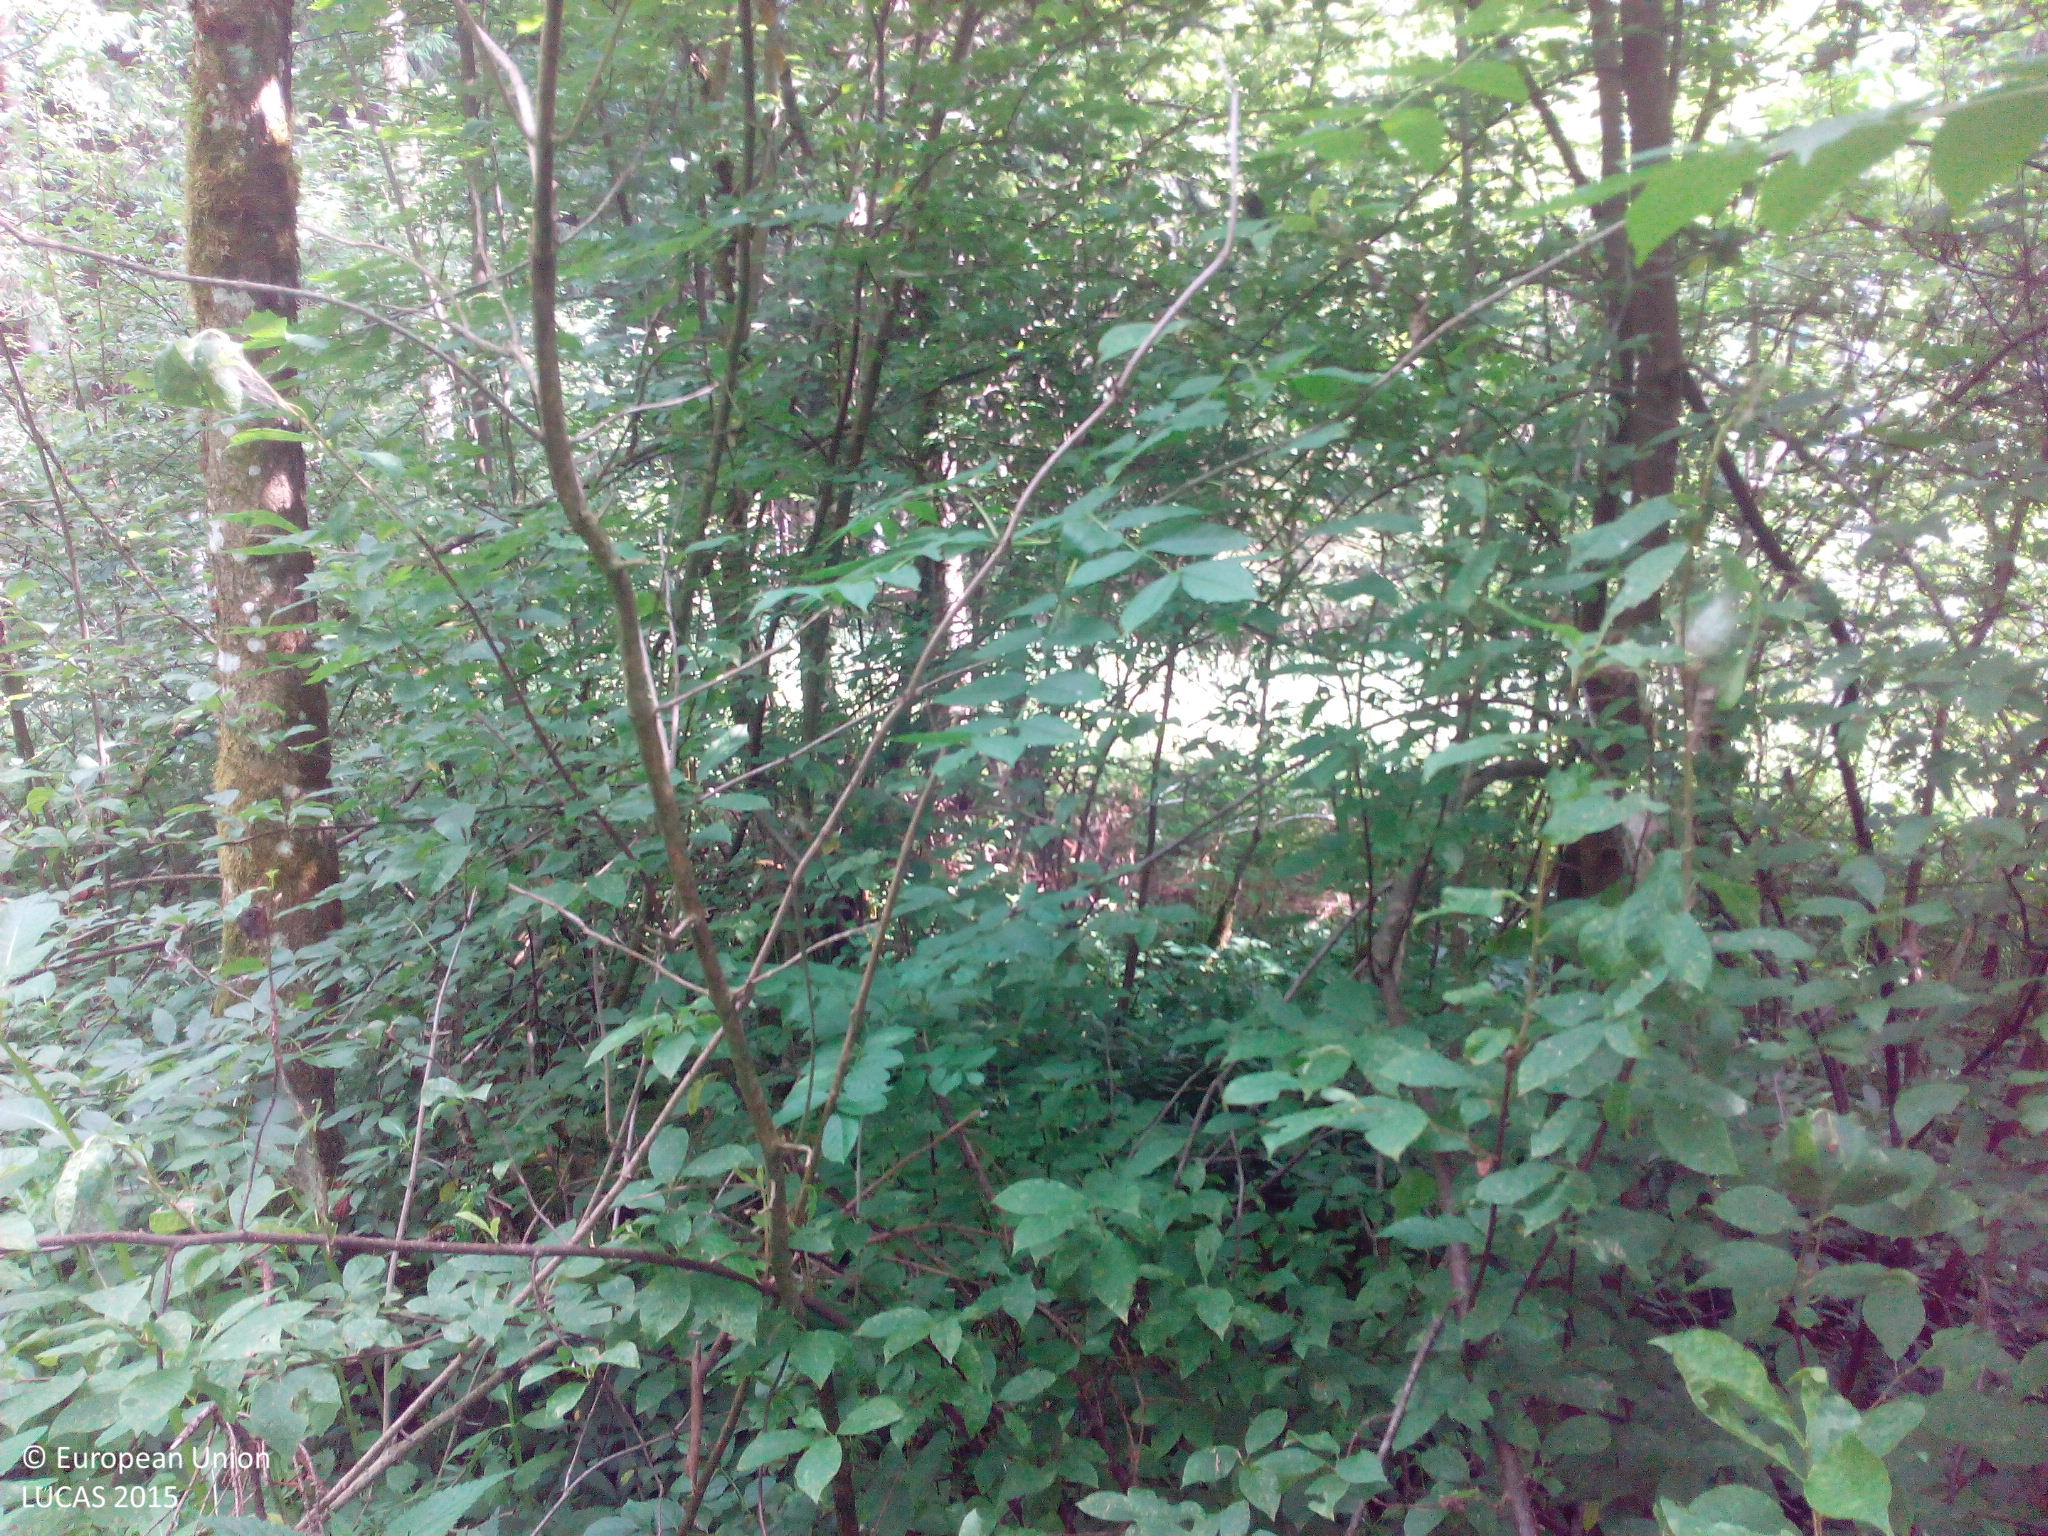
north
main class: Woodland
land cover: Other mixed woodland
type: hemiboreal forest and nemoral coniferous forest and mixed broadleaved-coniferous forest
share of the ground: > 75 %
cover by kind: broadleaved forest trees 55 %, coniferous forest trees 25 %, shrubs 10 %, herbaceous plants 10 %
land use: Forestry
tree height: > 5 m
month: June
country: DE
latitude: 47.7196
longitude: 9.9334
